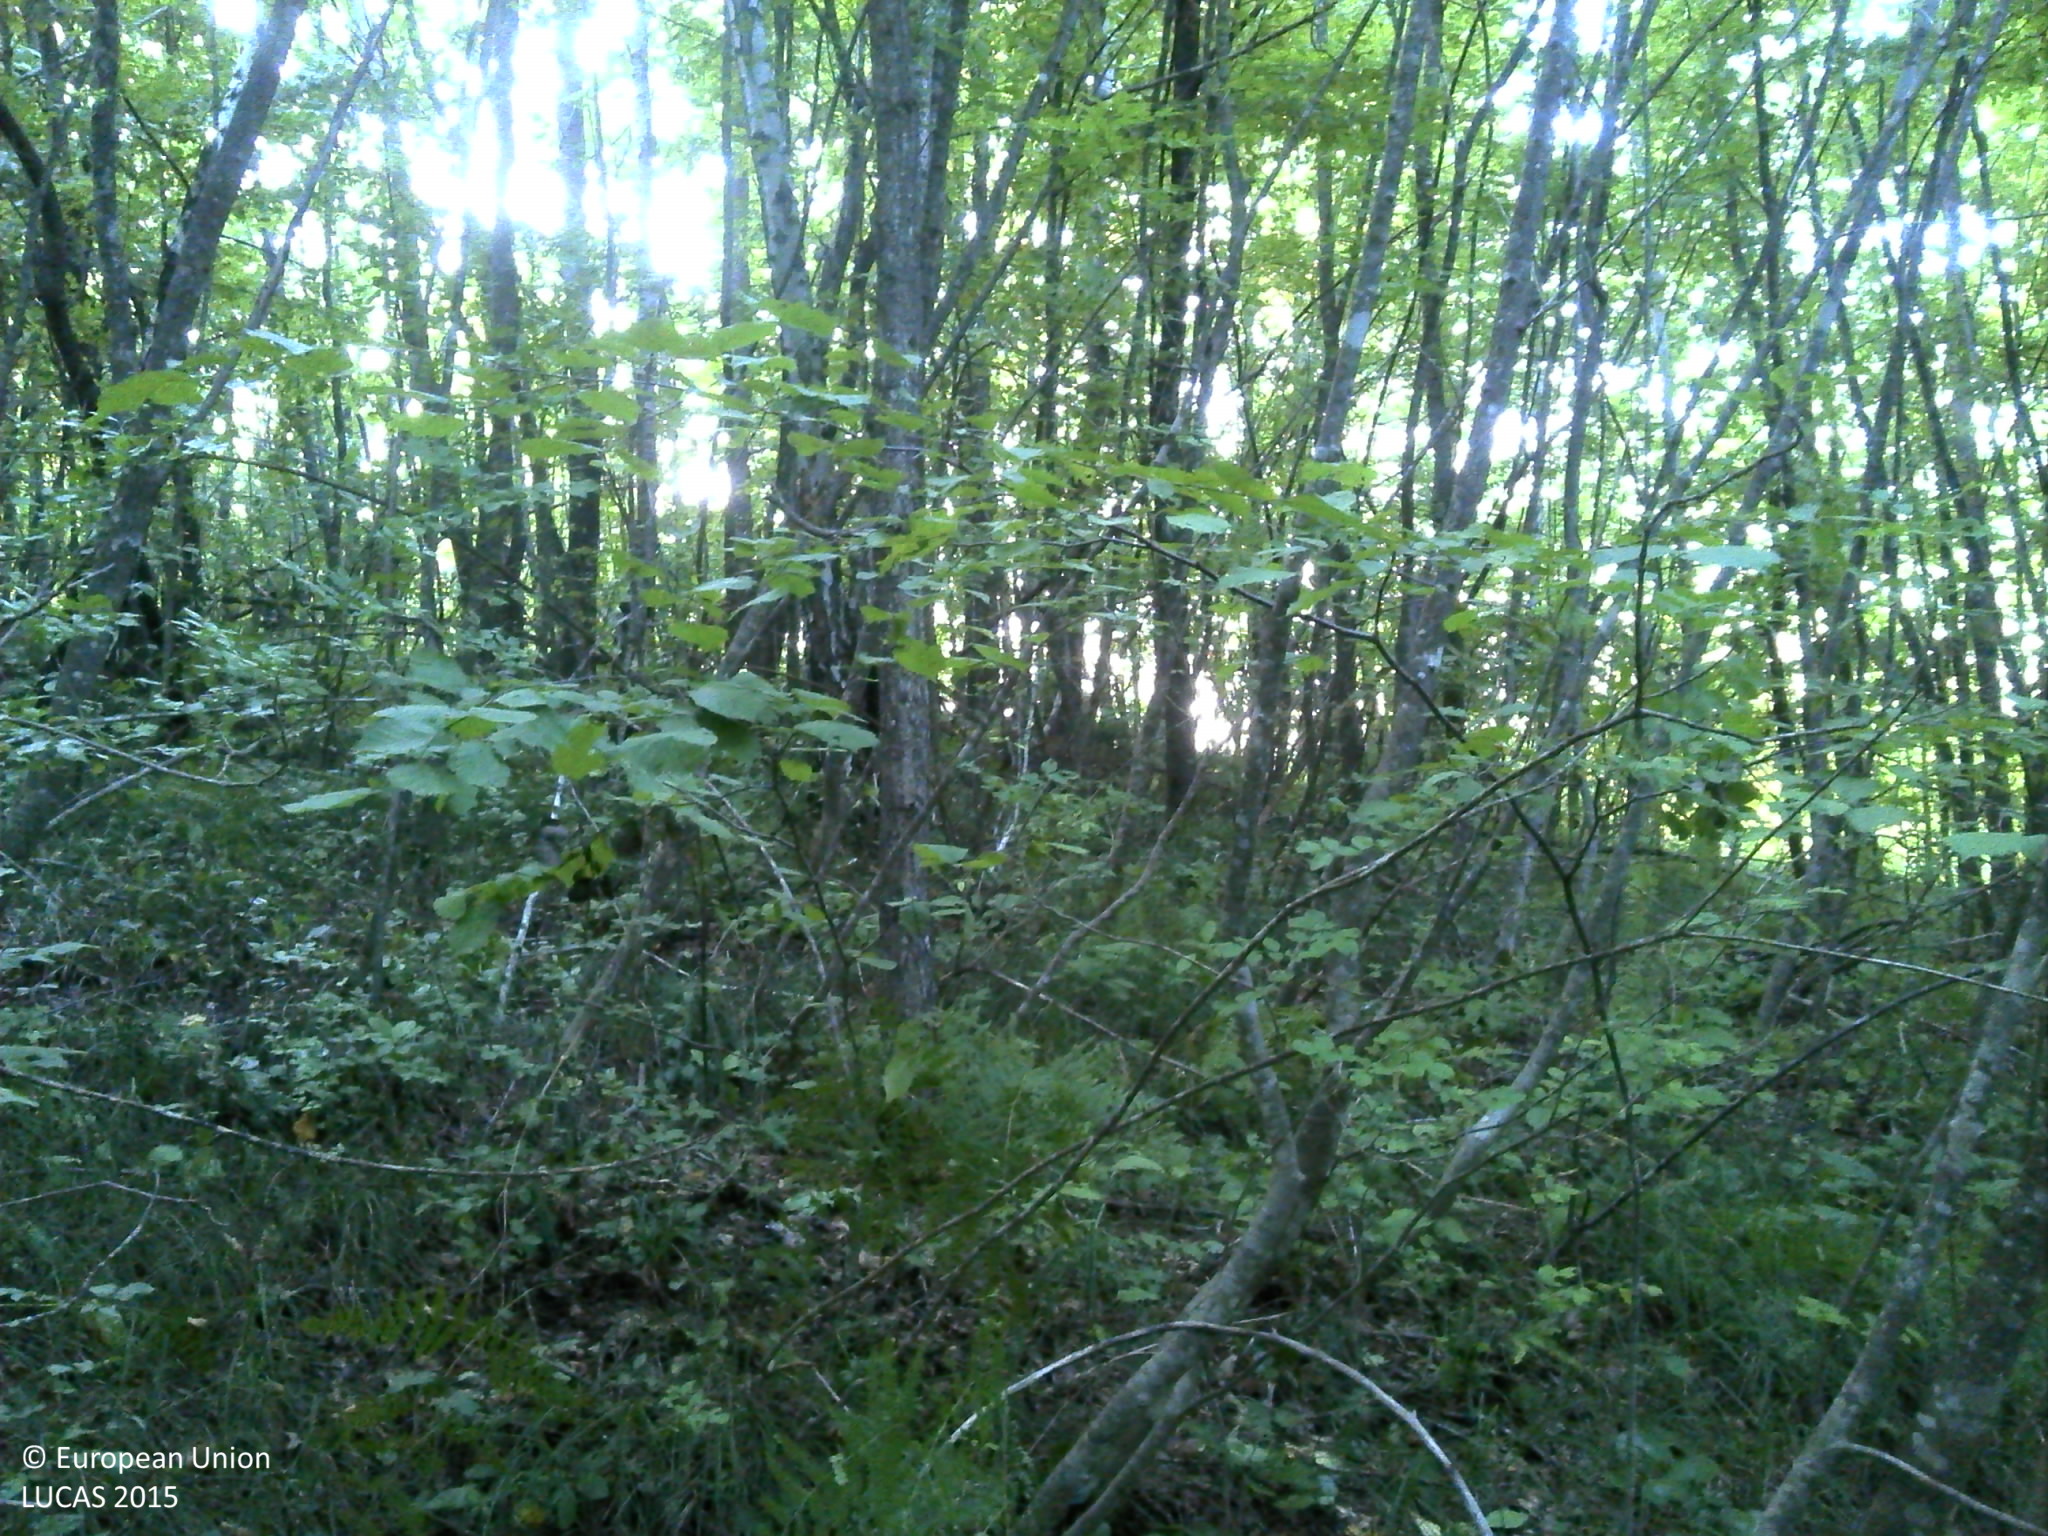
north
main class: Woodland
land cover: Broadleaved woodland
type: beech forest
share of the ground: > 75 %
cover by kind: broadleaved forest trees 100 %
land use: Forestry
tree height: > 5 m
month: August
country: HR
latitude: 45.2852
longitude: 16.5124
